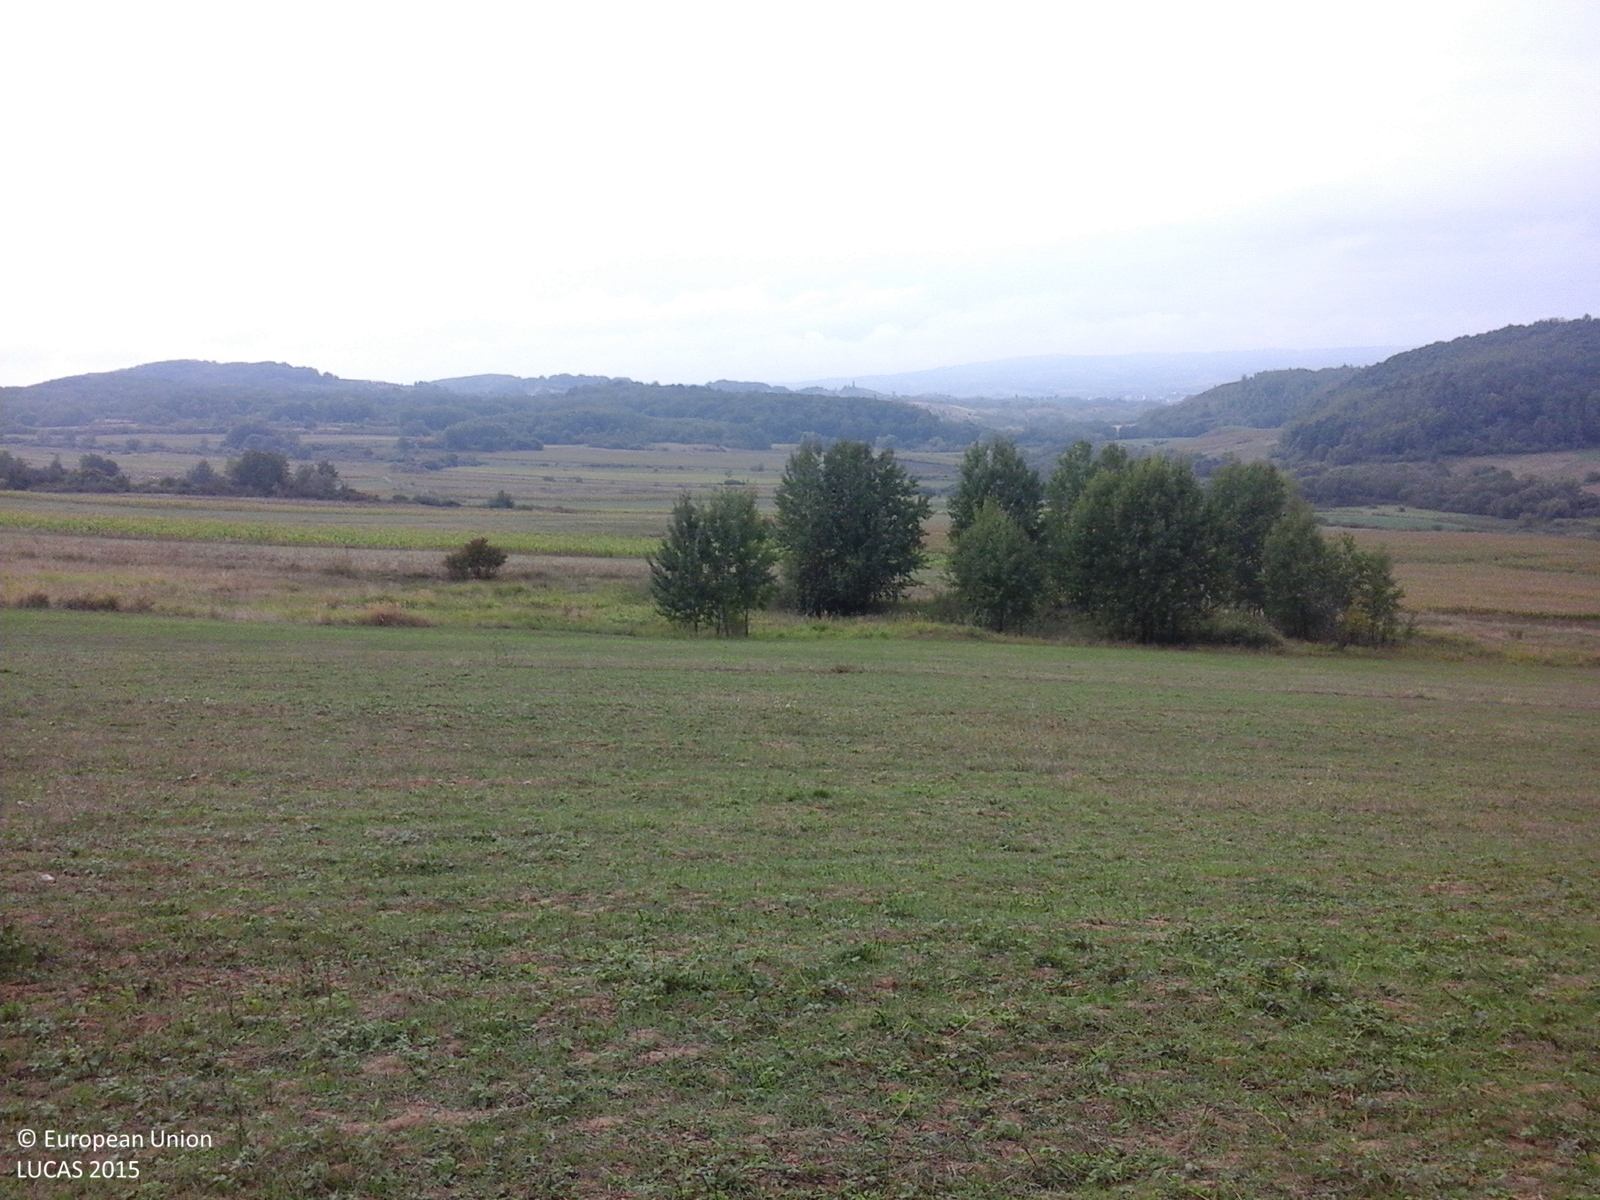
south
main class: Grassland
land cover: Grassland without tree/shrub cover
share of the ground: > 75 %
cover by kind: herbaceous plants 100 %
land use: Agriculture (excluding fallow land and kitchen gardens)
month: September
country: RO
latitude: 45.4729
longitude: 21.9984
